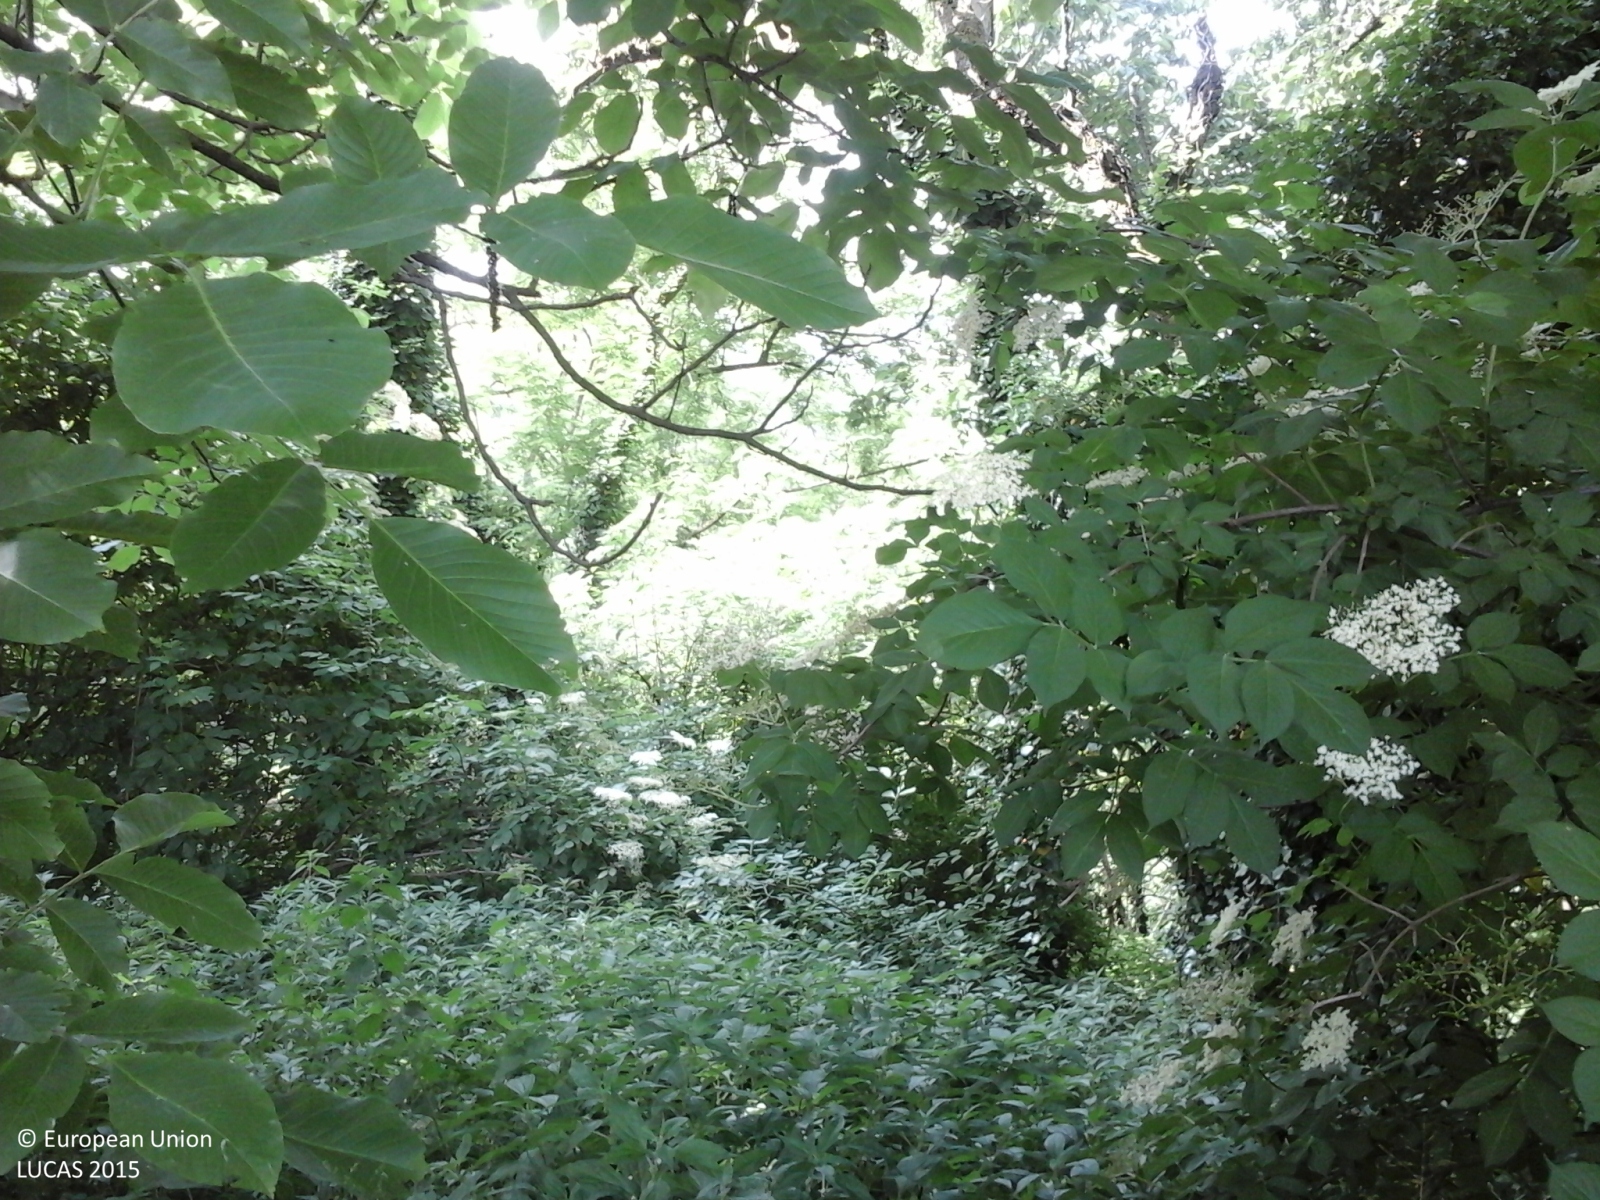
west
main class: Woodland
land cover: Broadleaved woodland
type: thermophilous deciduous forest
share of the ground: > 75 %
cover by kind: broadleaved forest trees 80 %, shrubs 10 %, herbaceous plants 10 %
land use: Forestry
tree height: > 5 m
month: May
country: IT
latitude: 44.6344
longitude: 7.8235
